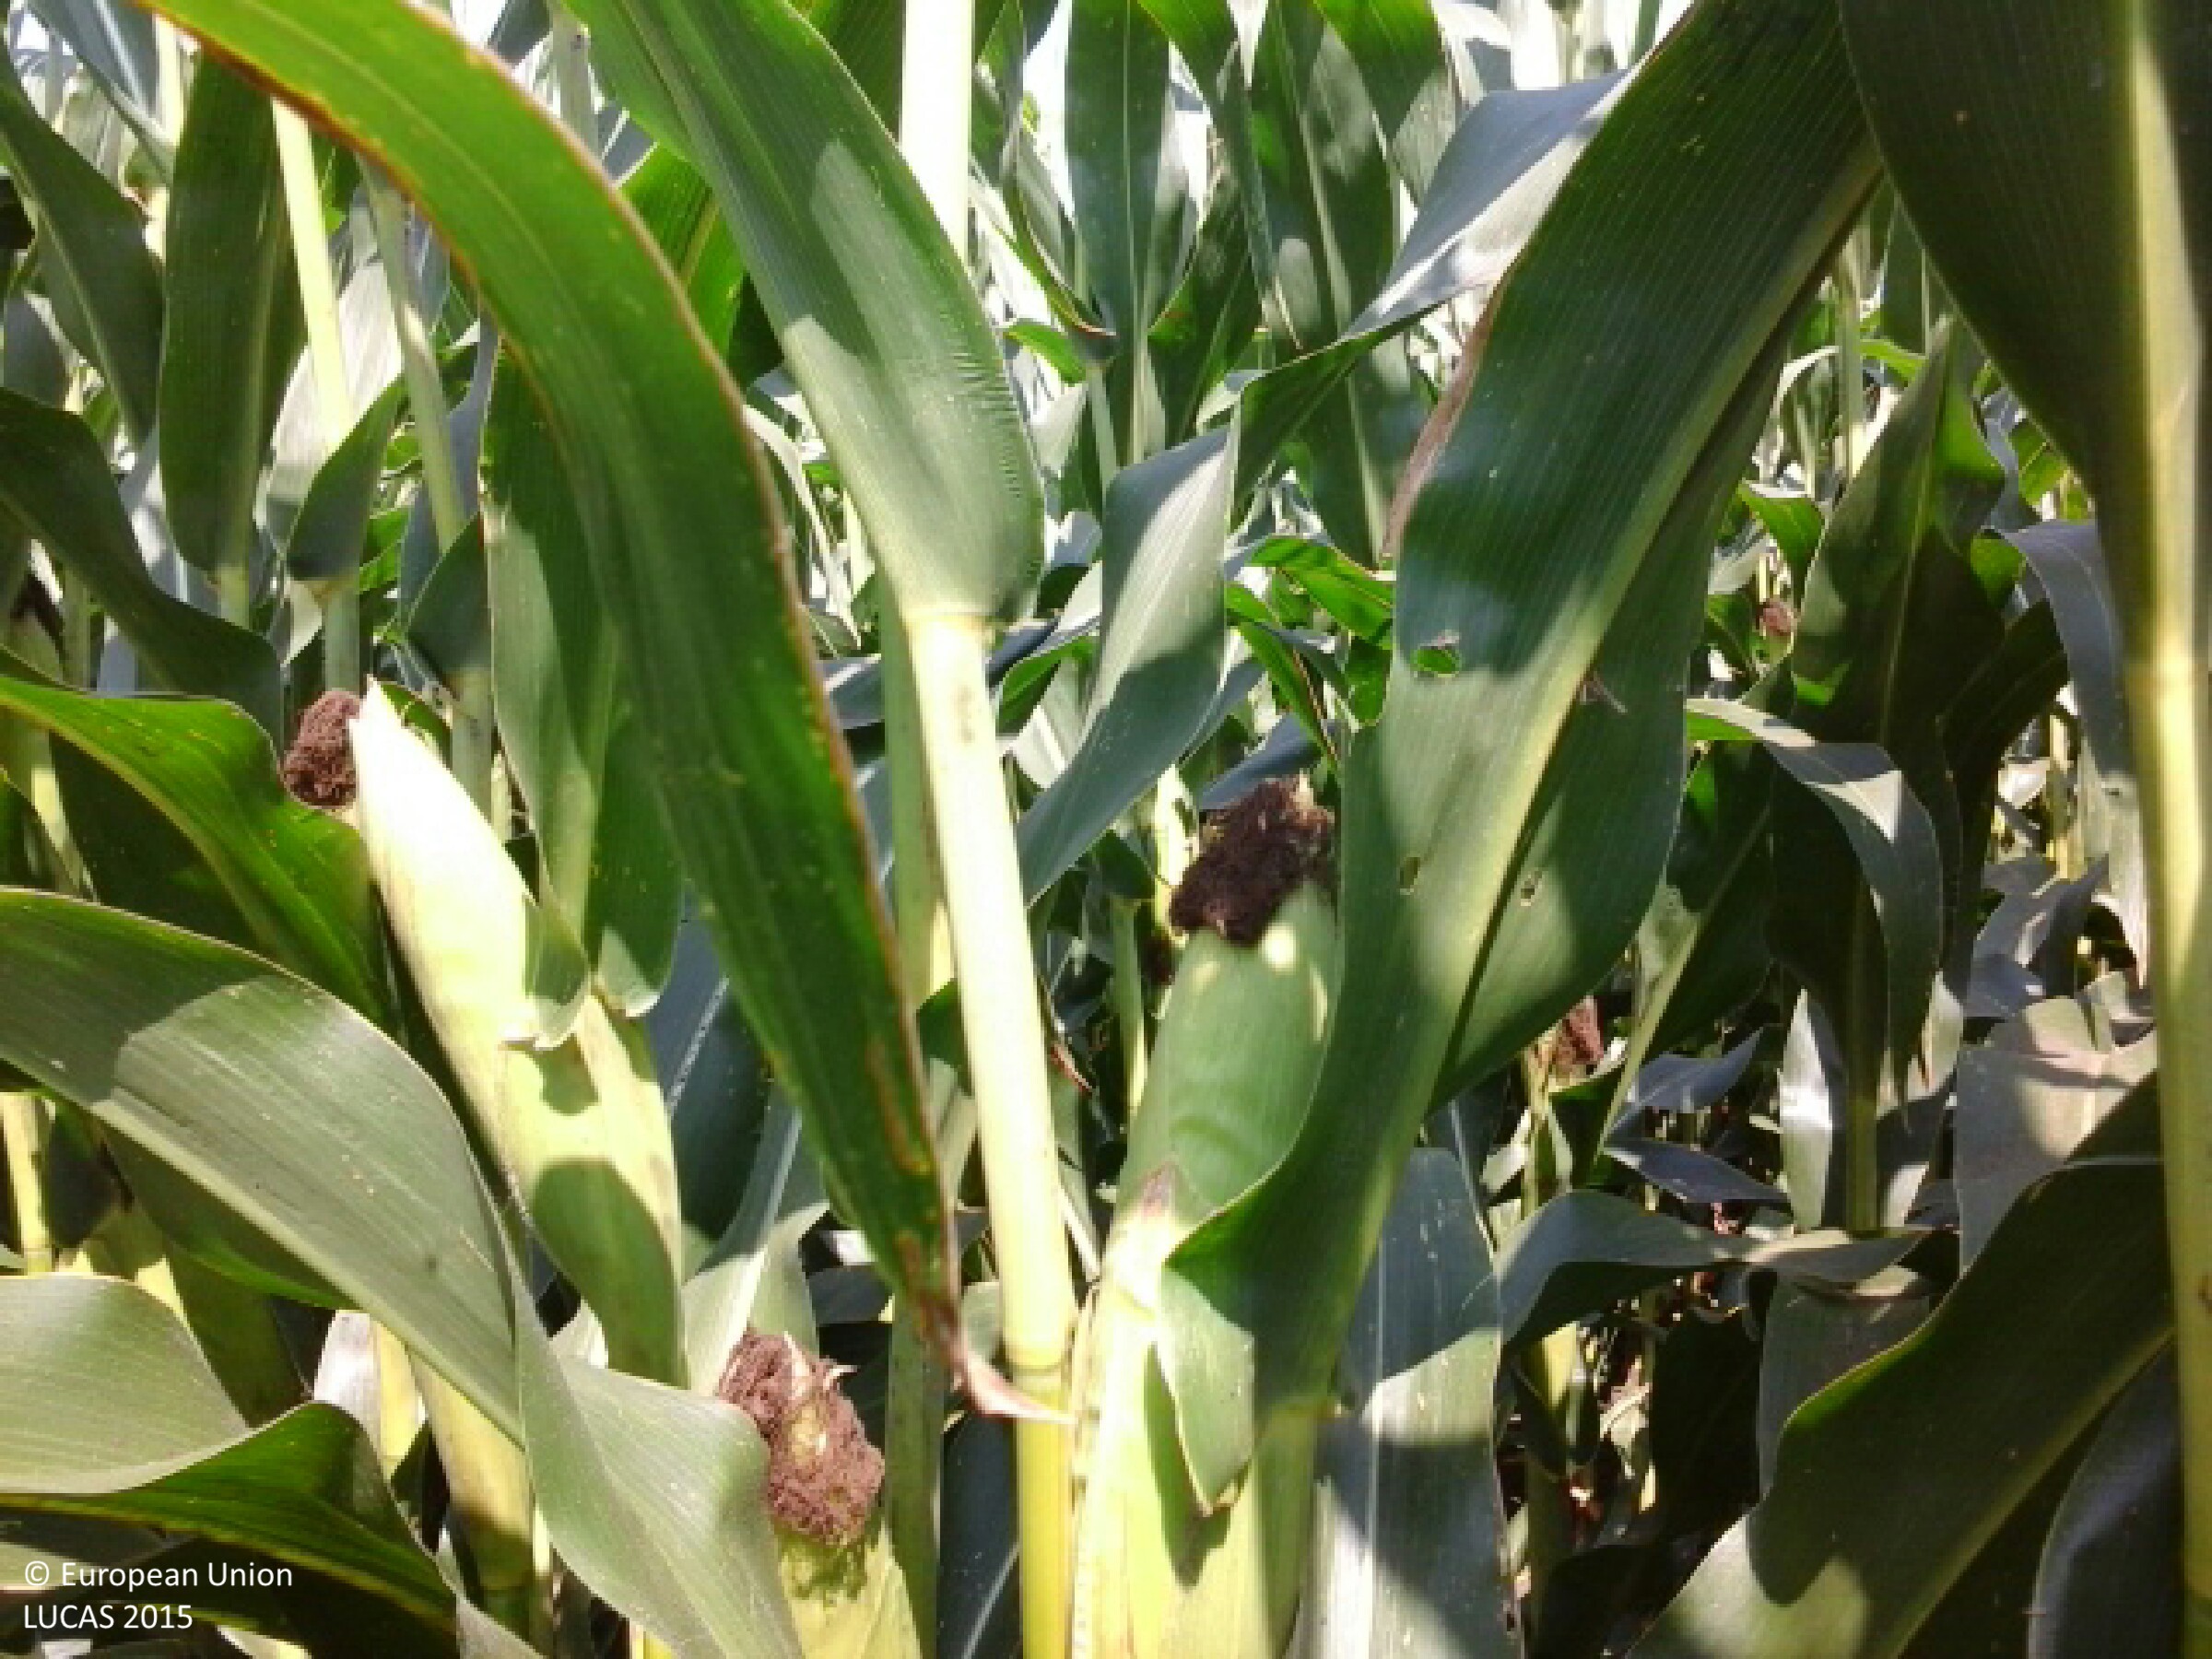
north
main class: Cropland
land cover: Maize
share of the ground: > 75 %
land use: Agriculture (excluding fallow land and kitchen gardens)
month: August
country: HU
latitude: 47.6325
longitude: 18.1436
